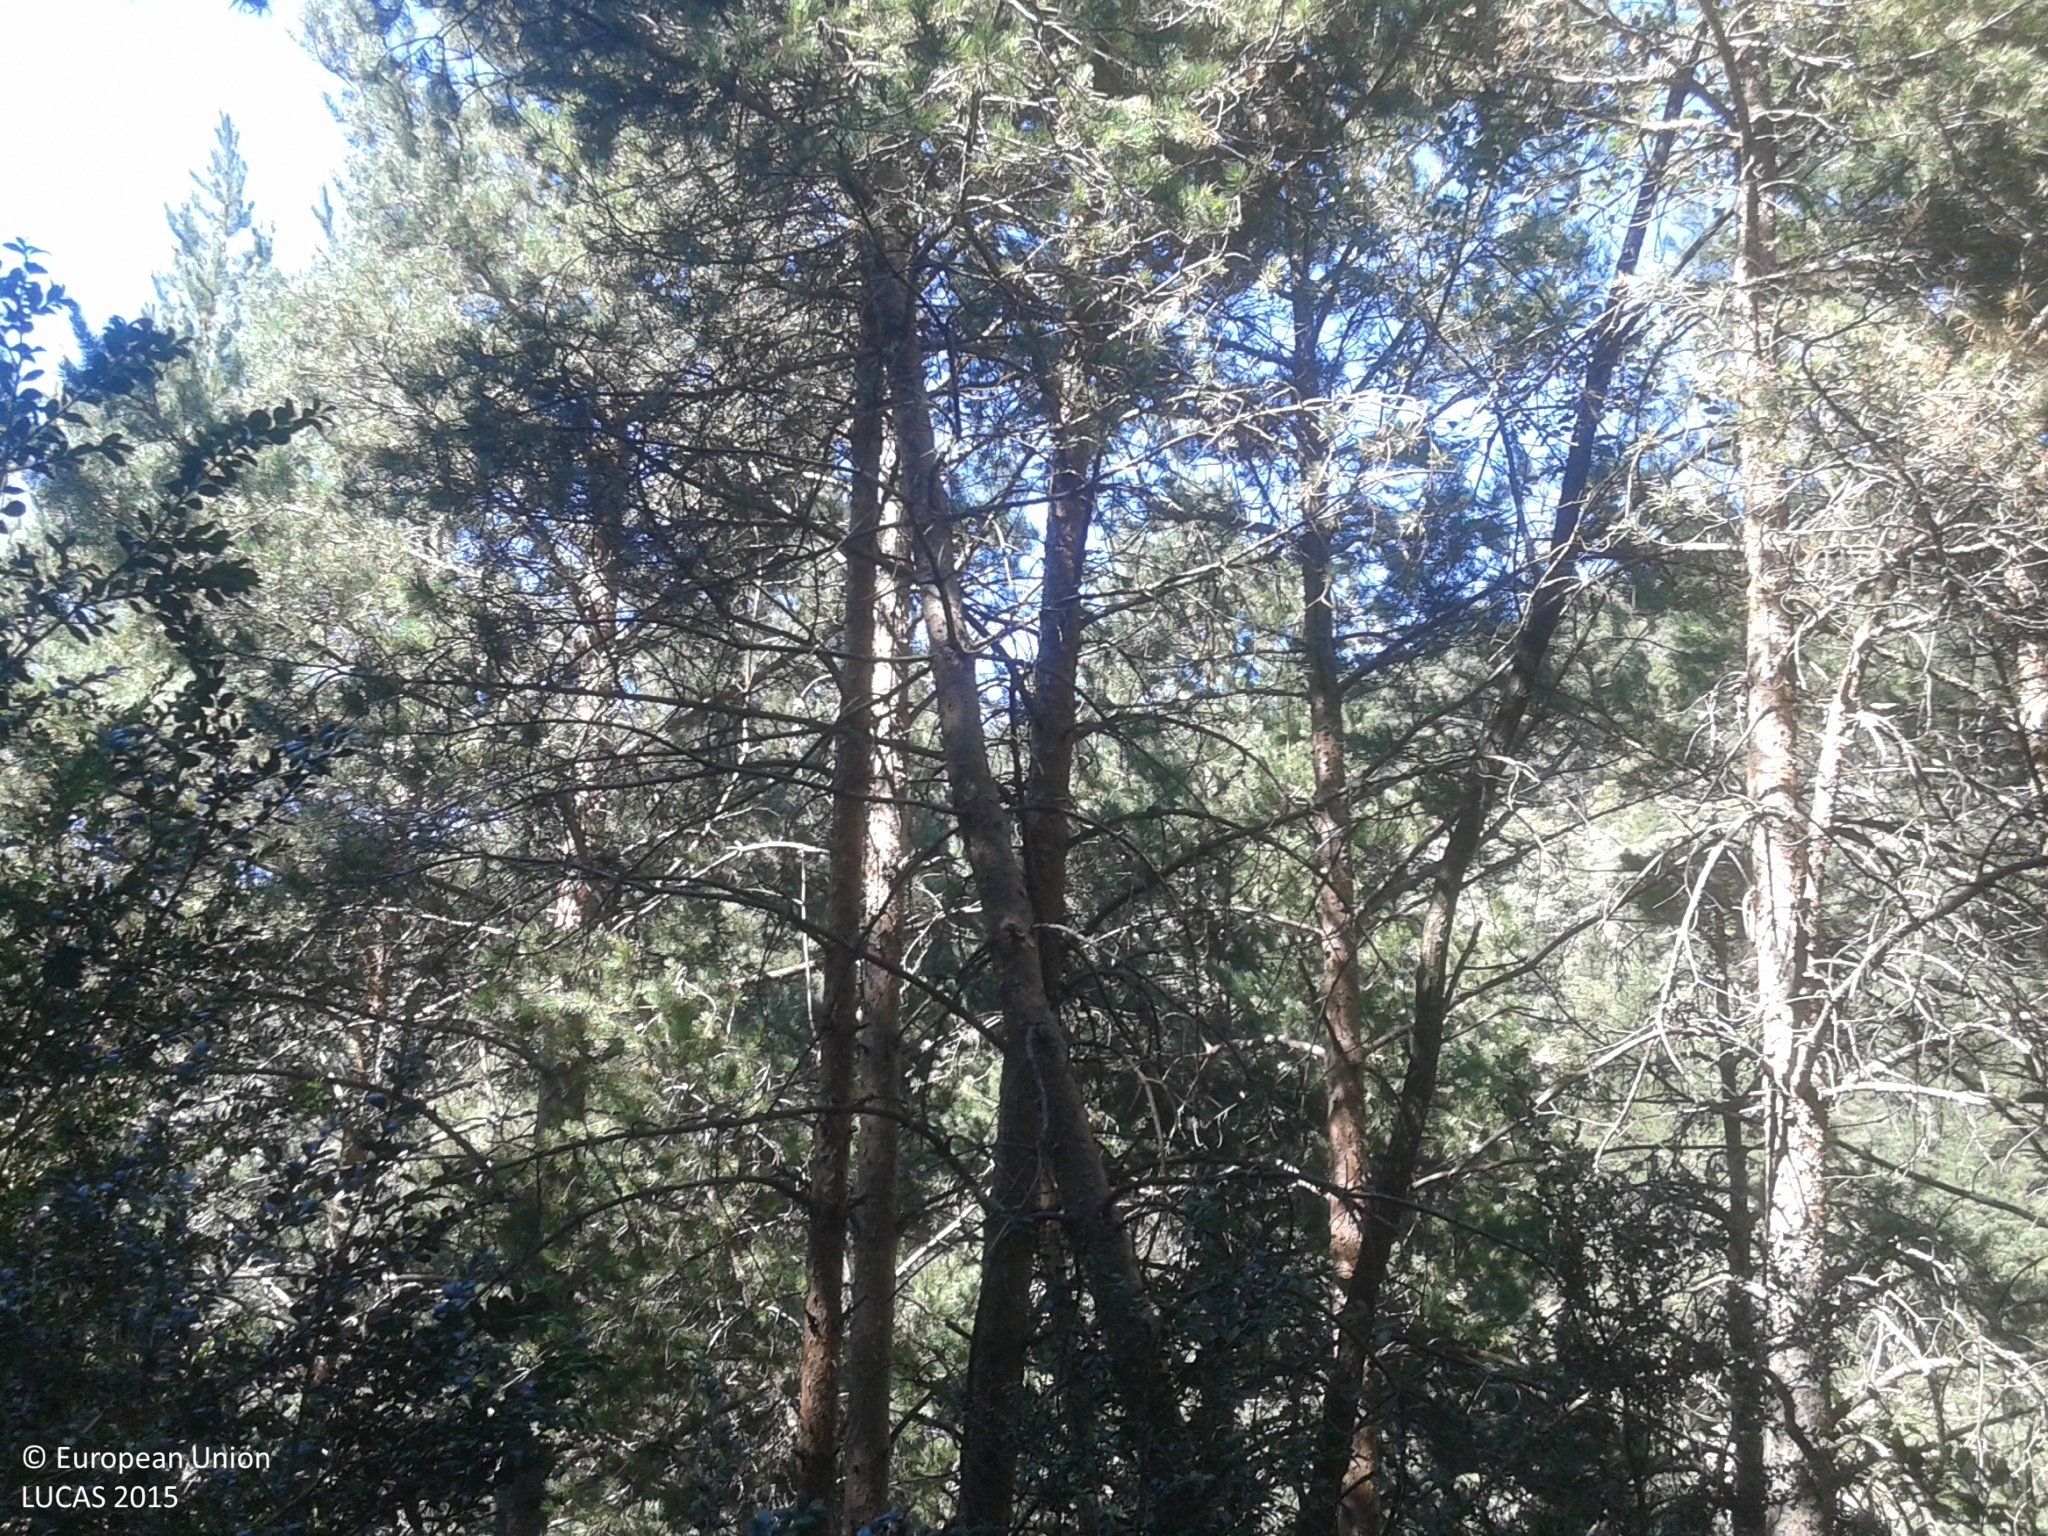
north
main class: Woodland
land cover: Pine dominated coniferous woodland
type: alpine coniferous forest
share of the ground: 50 - 75 %
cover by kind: coniferous forest trees 70 %, shrubs 30 %
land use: Semi-natural and natural areas not in use
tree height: > 5 m
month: July
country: ES
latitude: 42.3168
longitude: 1.5294
